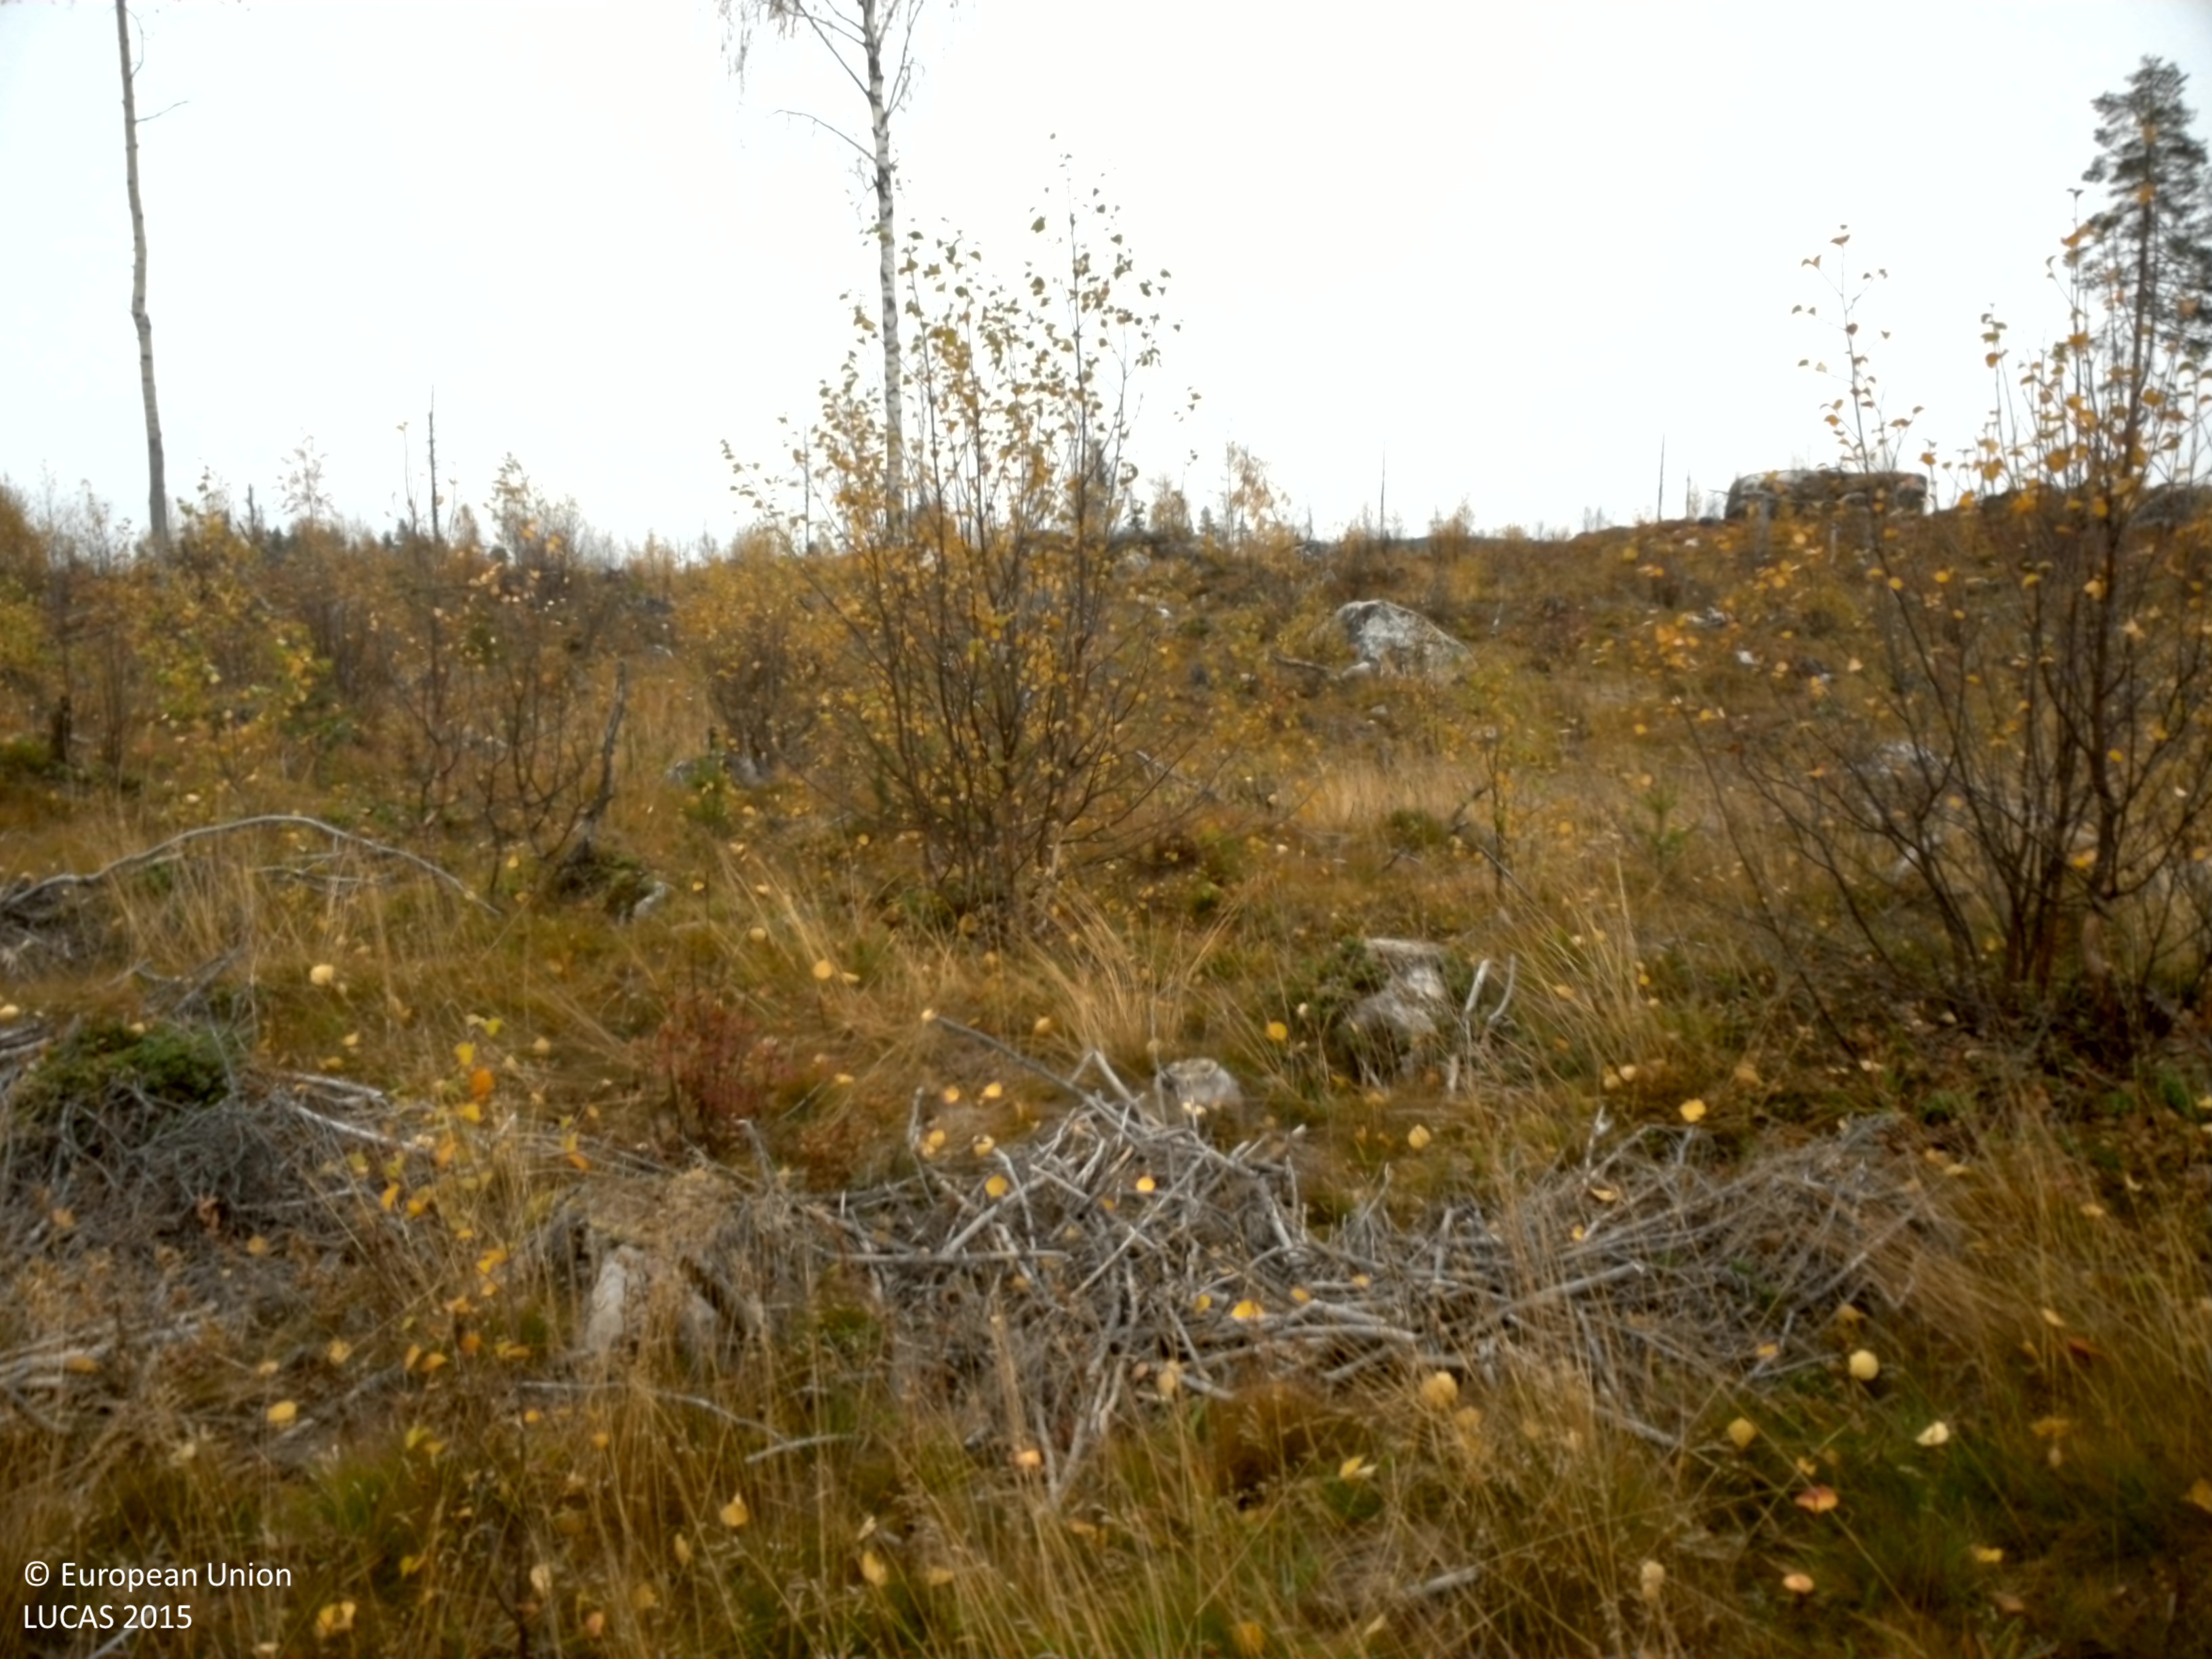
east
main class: Woodland
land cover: Broadleaved woodland
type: non-riverine alder, birch or aspen forest
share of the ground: 10 - 25 %
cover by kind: herbaceous plants 65 %, lichens and mosses 15 %, broadleaved forest trees 10 %, shrubs 5 %, unconsolidated bare surface 5 %
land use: Forestry
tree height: < 5 m
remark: Clear cut
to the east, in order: Broadleaved woodland; Shrubland with sparse tree cover; Broadleaved woodland; Shrubland with sparse tree cover
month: October
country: SE
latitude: 64.9480
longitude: 17.4777
